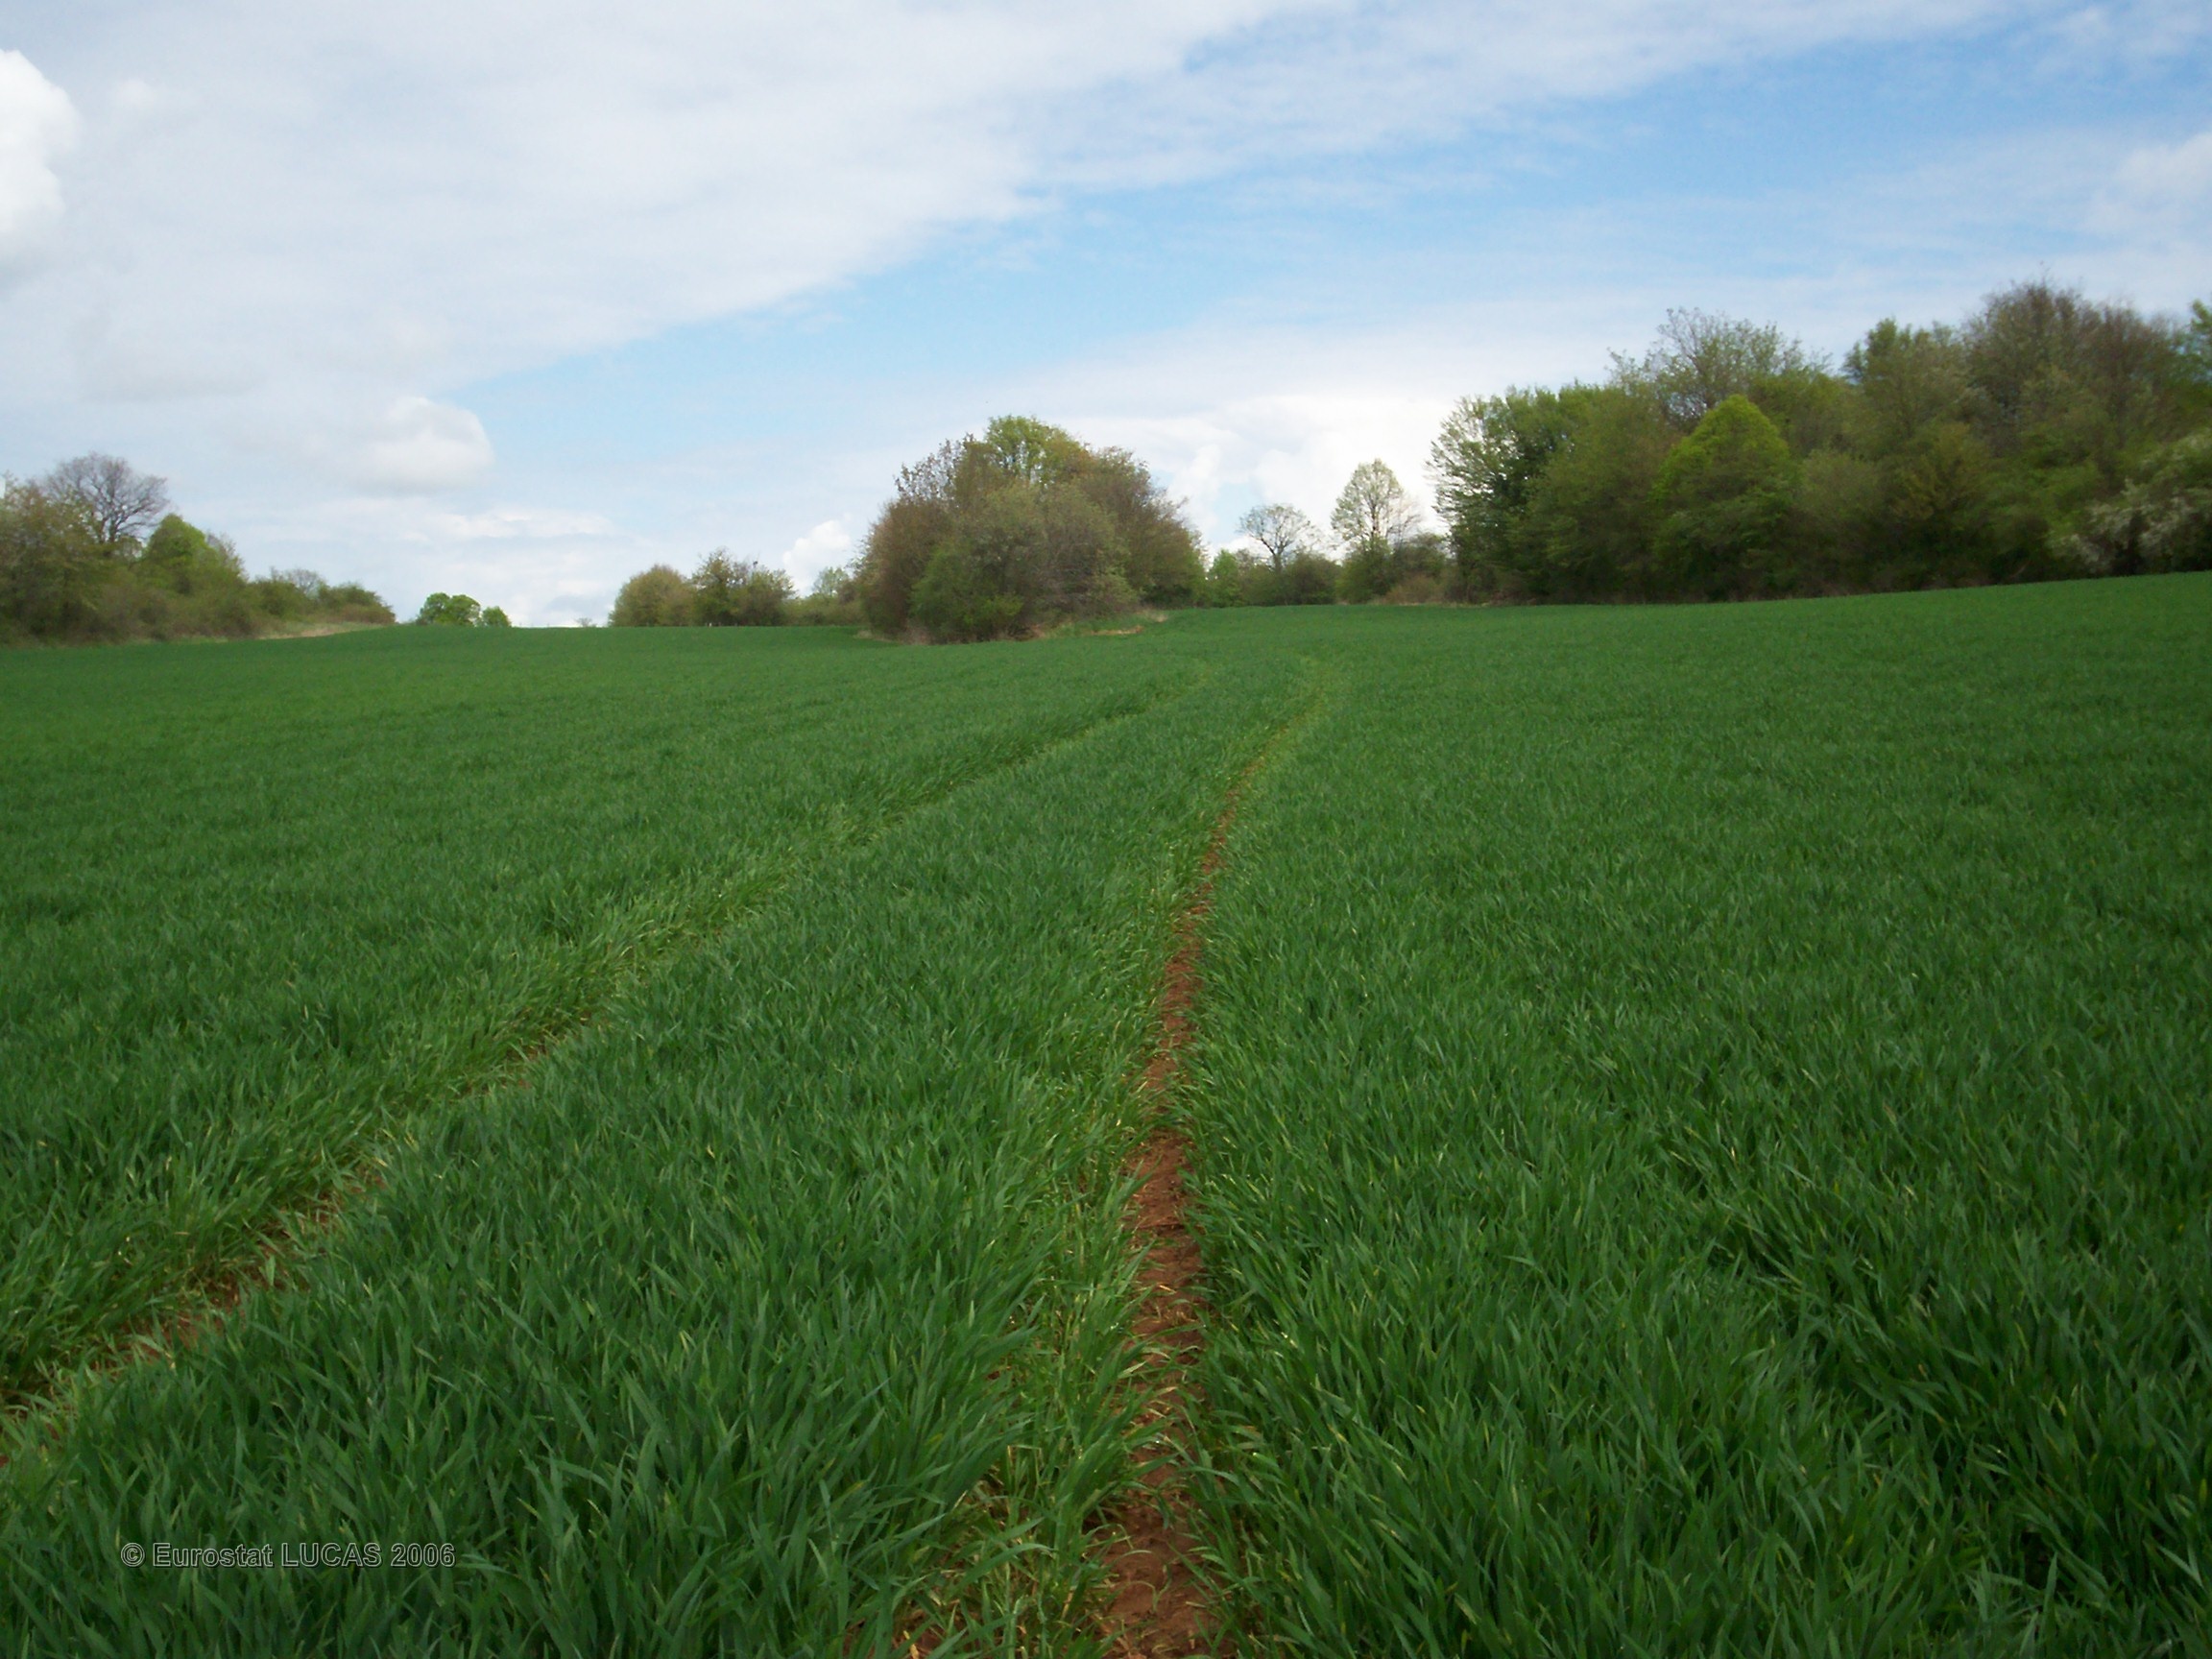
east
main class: Cropland
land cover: Common wheat
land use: Agriculture (excluding fallow land and kitchen gardens)
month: April
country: FR
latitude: 47.6132
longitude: 6.0766
